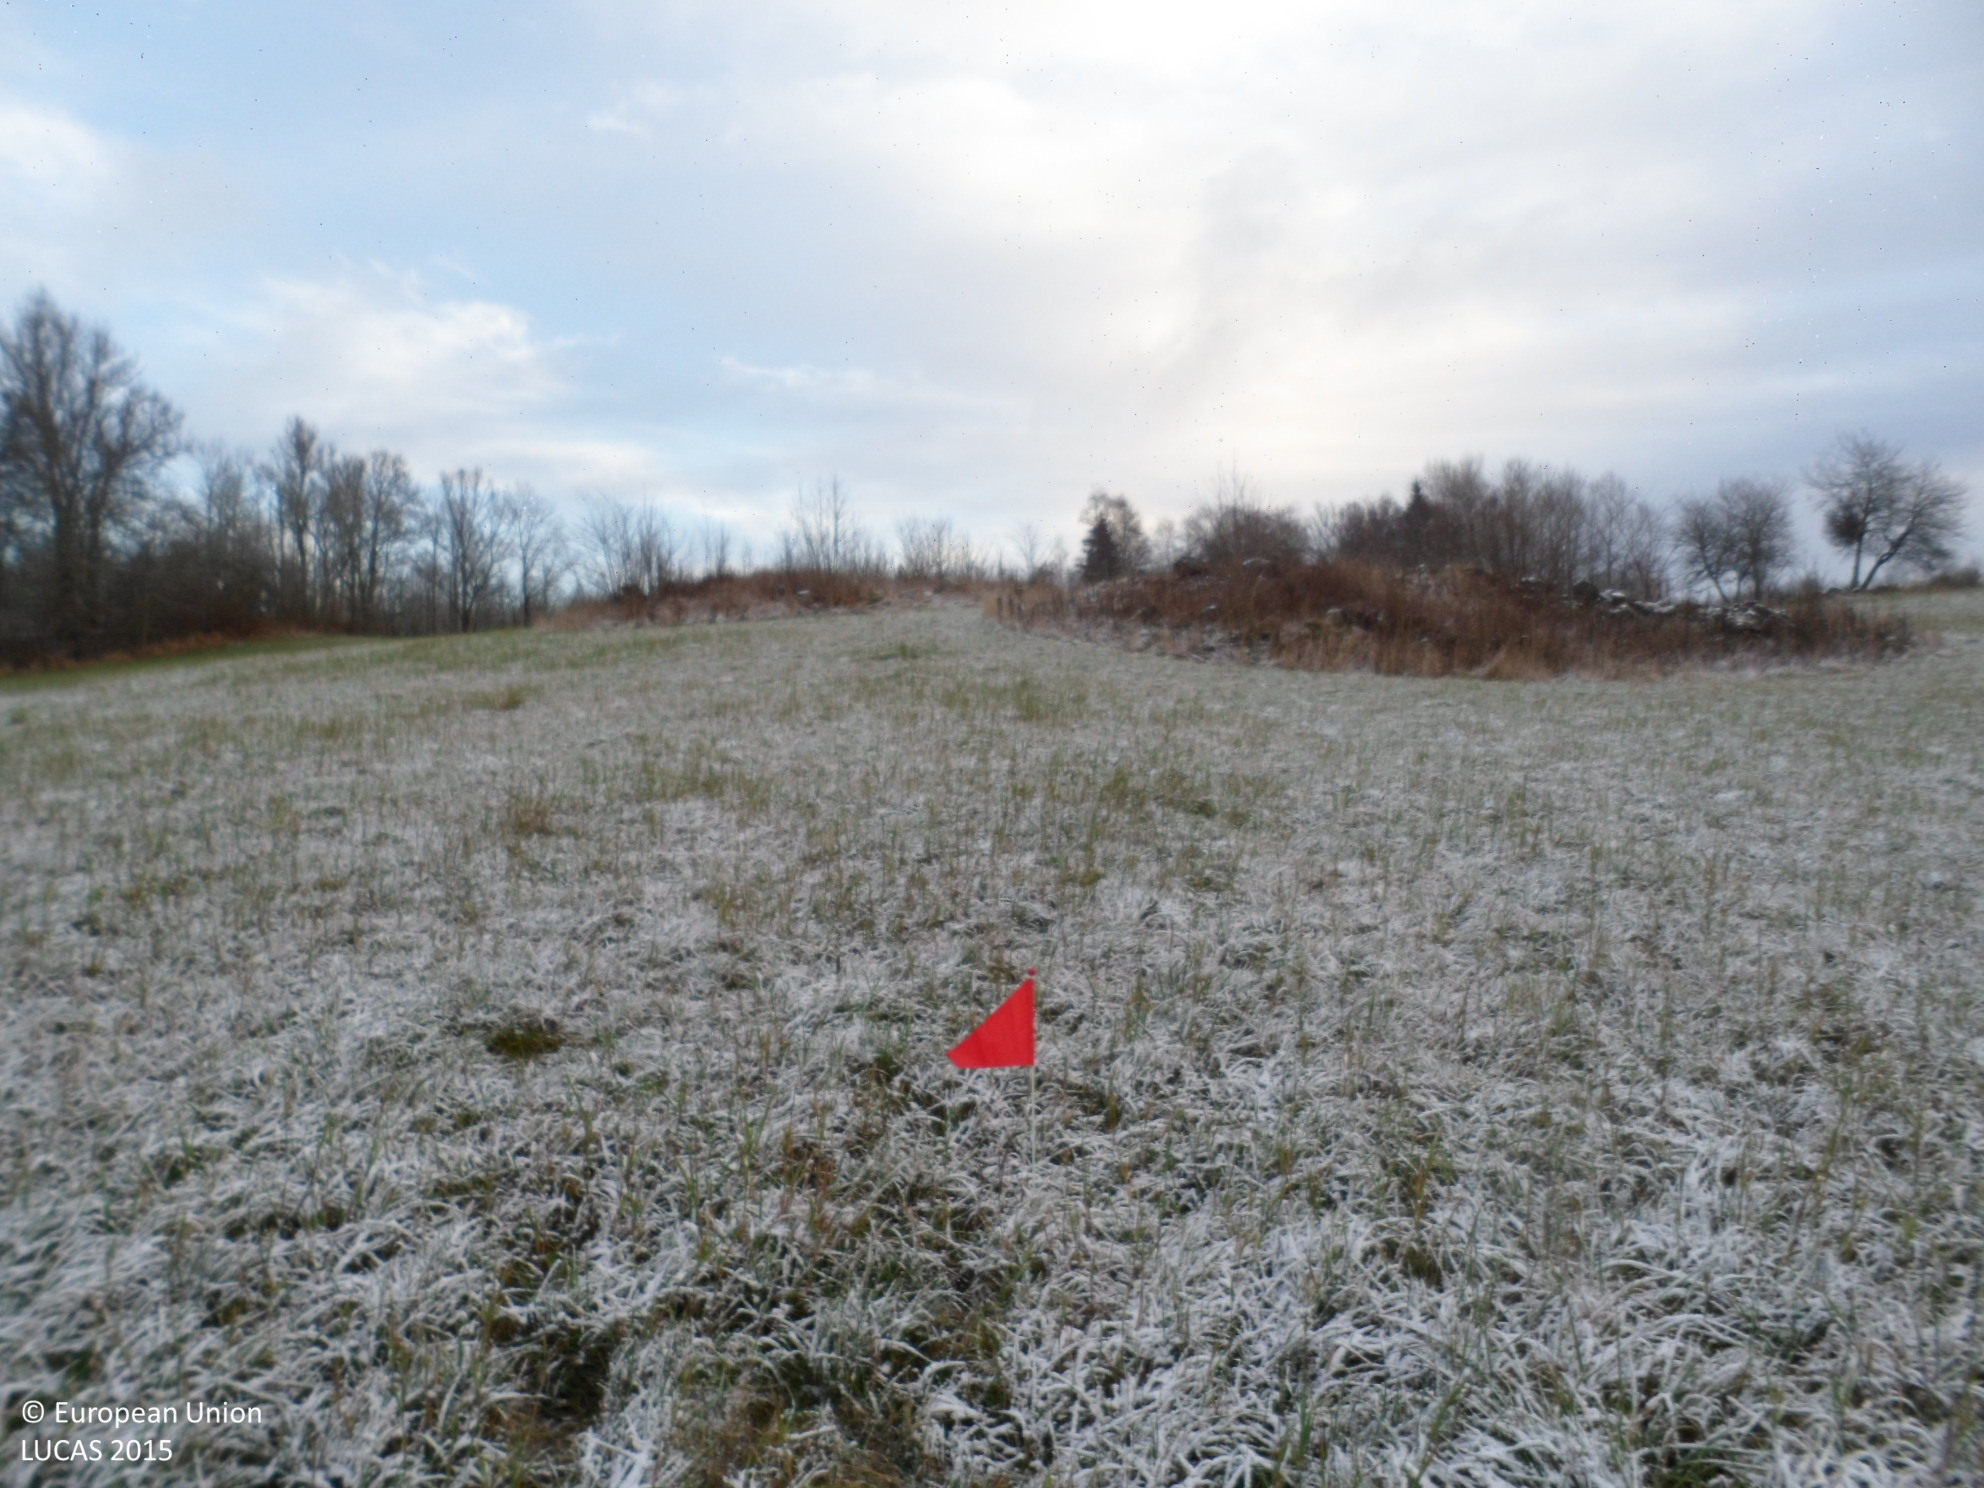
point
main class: Grassland
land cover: Grassland without tree/shrub cover
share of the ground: > 75 %
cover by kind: herbaceous plants 100 %
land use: Agriculture (excluding fallow land and kitchen gardens)
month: November
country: SE
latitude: 57.8192
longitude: 14.5235
